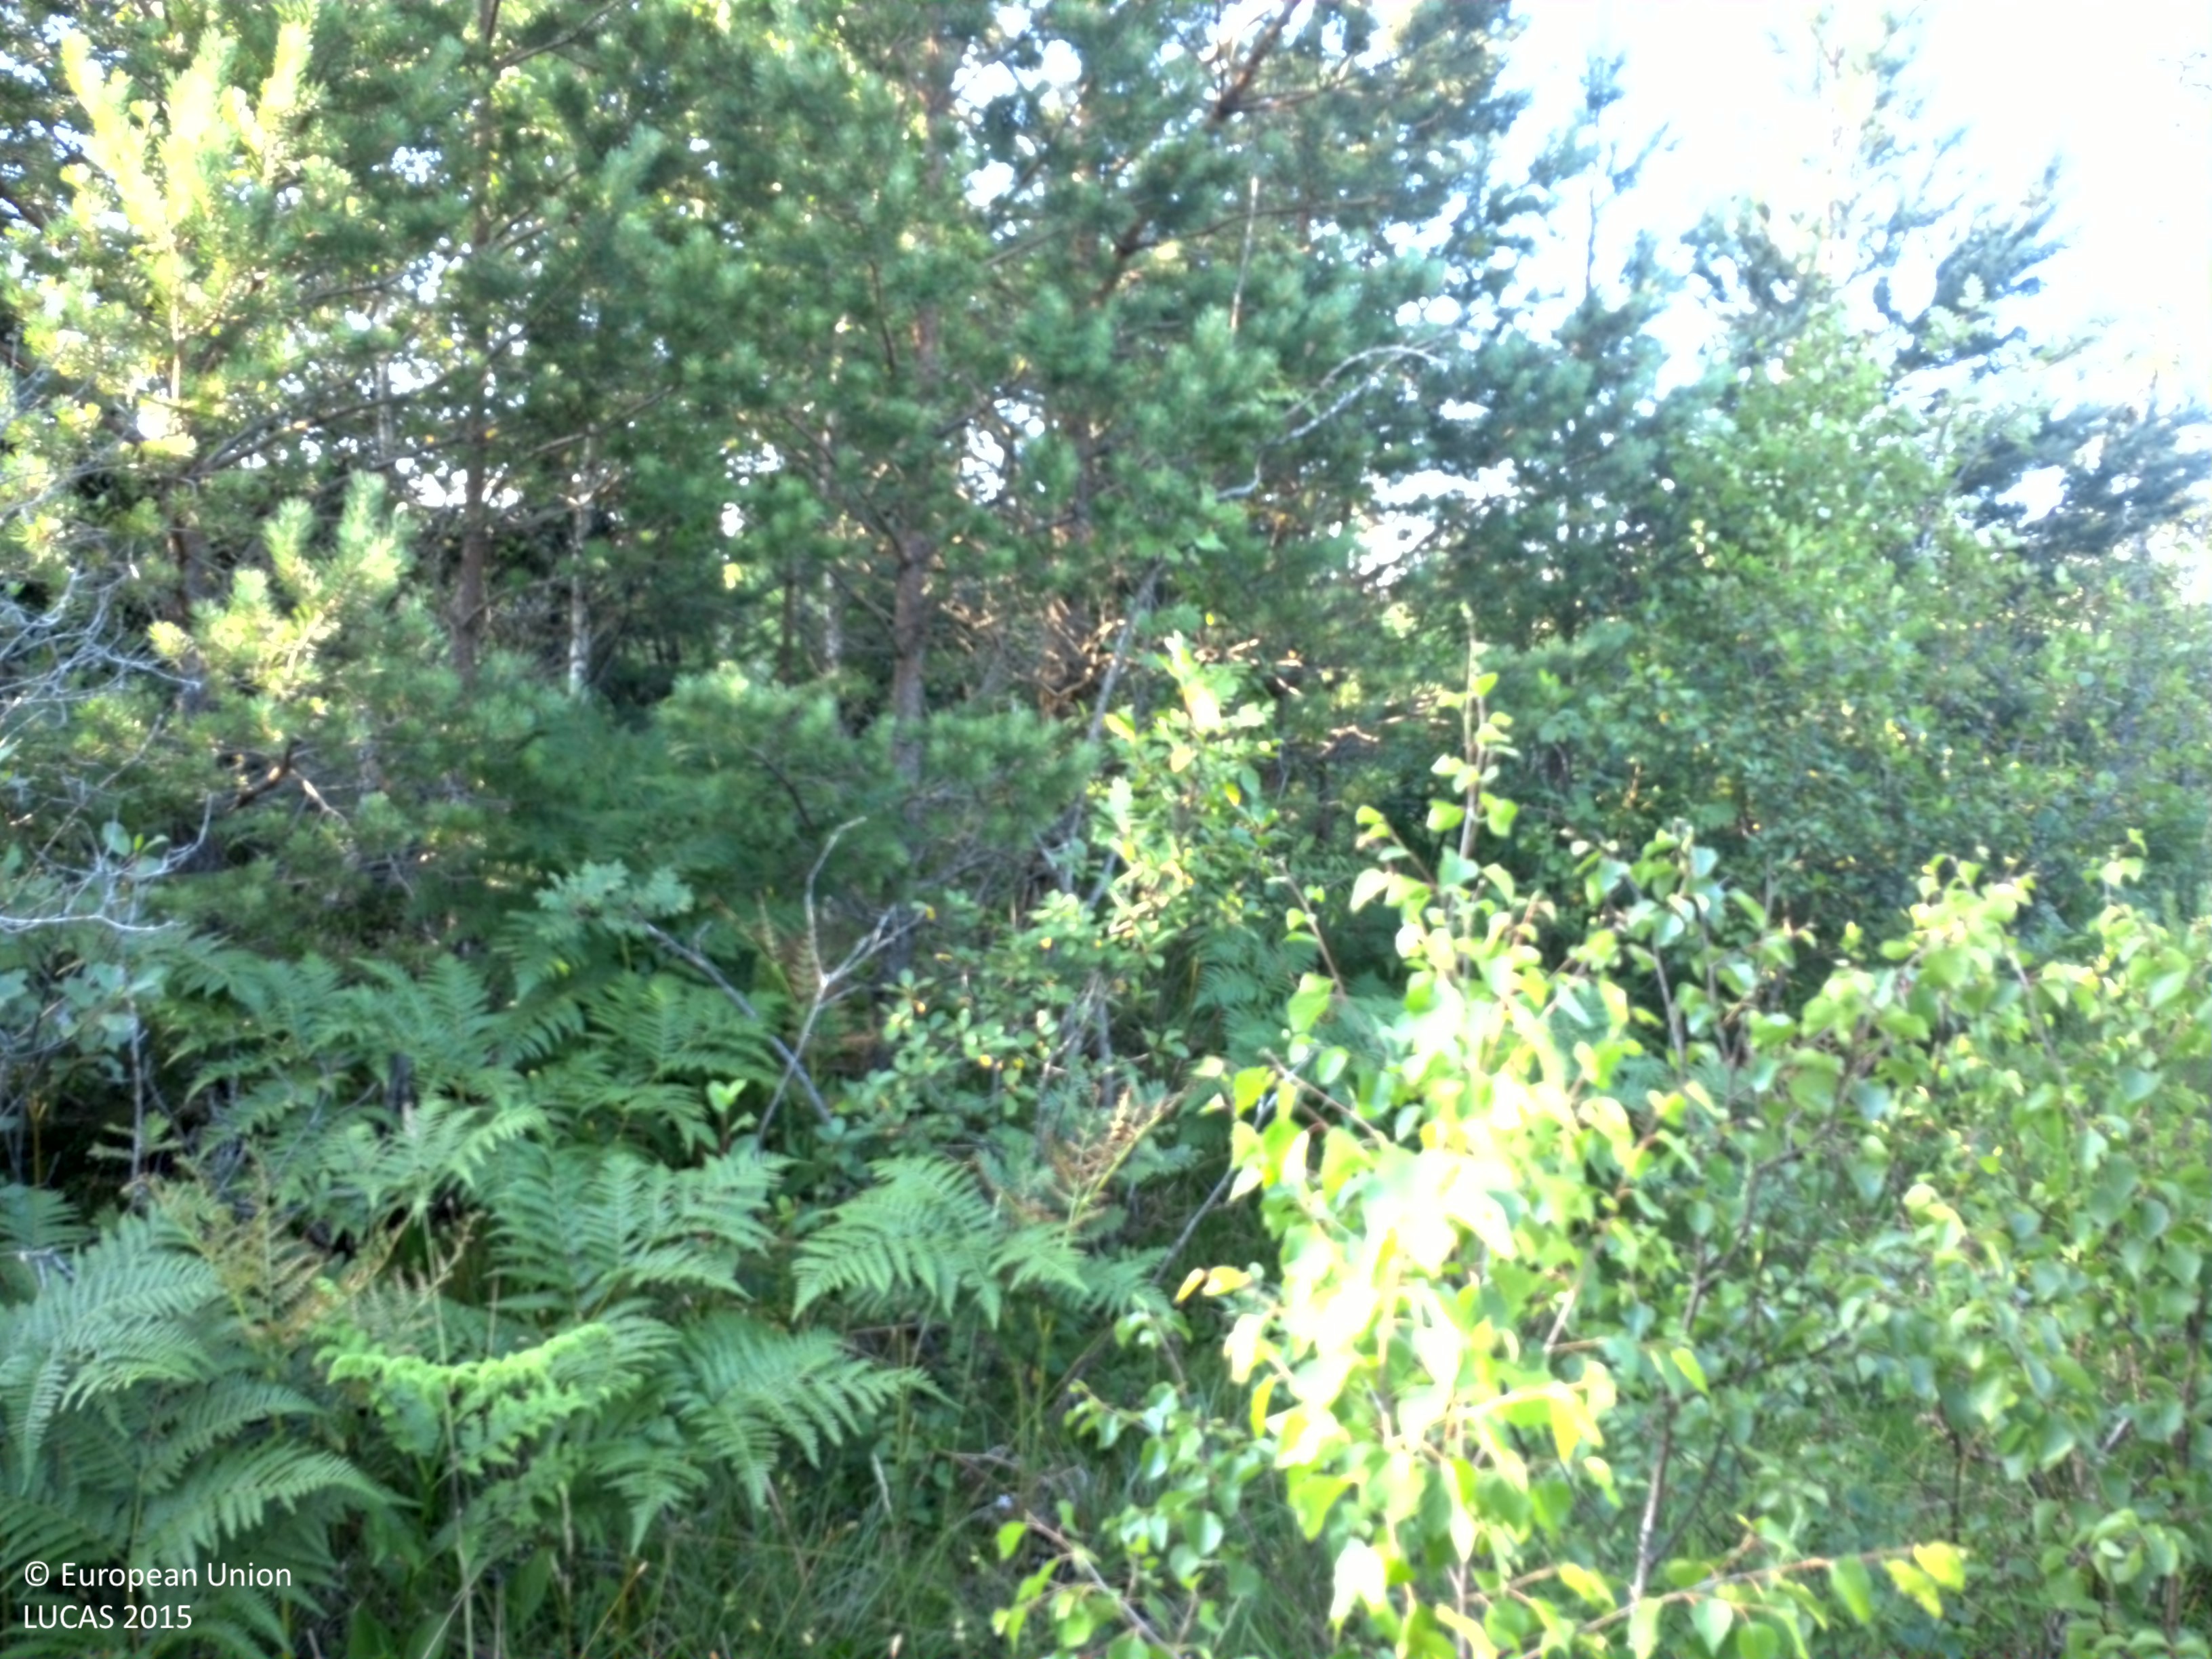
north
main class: Woodland
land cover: Other mixed woodland
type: hemiboreal forest and nemoral coniferous forest and mixed broadleaved-coniferous forest
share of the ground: > 75 %
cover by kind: broadleaved forest trees 35 %, coniferous forest trees 30 %, herbaceous plants 30 %, shrubs 5 %
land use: Forestry
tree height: < 5 m
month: July
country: SE
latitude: 57.4823
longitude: 18.7335
